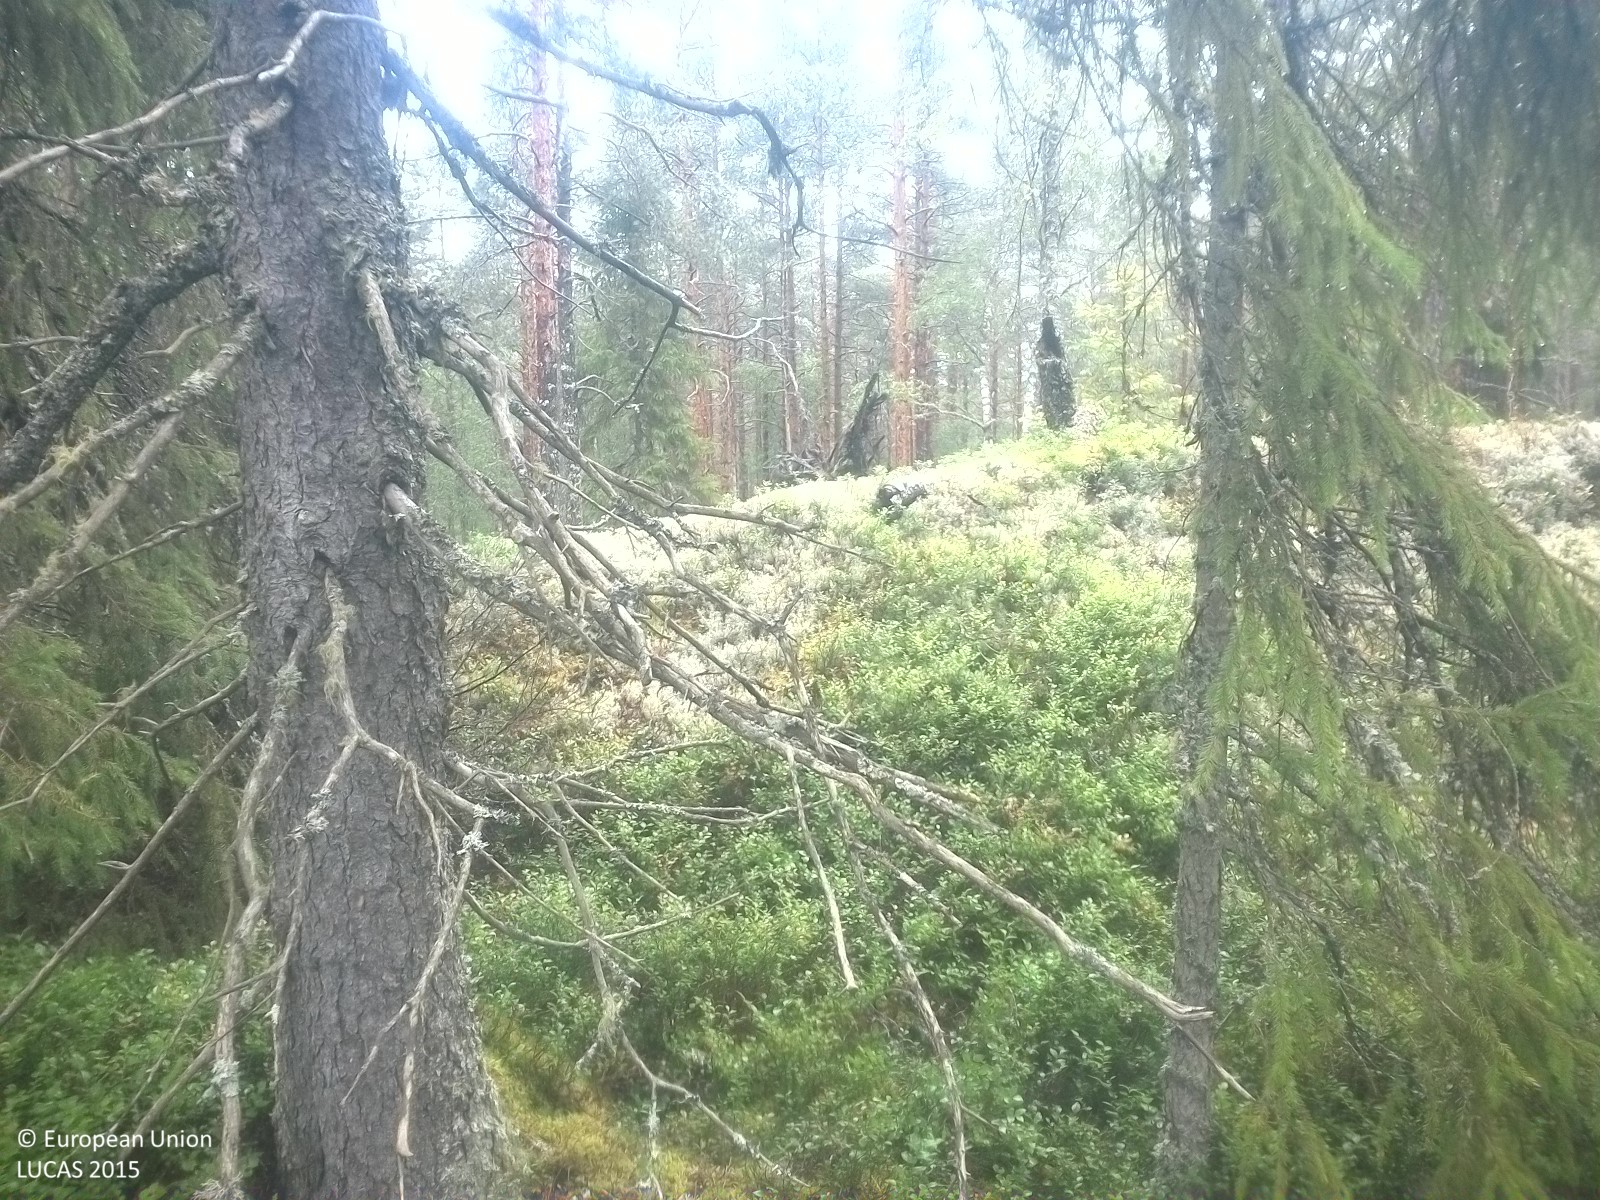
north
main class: Woodland
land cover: Pine dominated coniferous woodland
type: boreal forest
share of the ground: 10 - 25 %
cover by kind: herbaceous plants 60 %, coniferous forest trees 20 %, shrubs 10 %, lichens and mosses 10 %
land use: Forestry
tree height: > 5 m
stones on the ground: 25 - 50 %
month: July
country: SE
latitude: 58.7707
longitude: 15.1289
